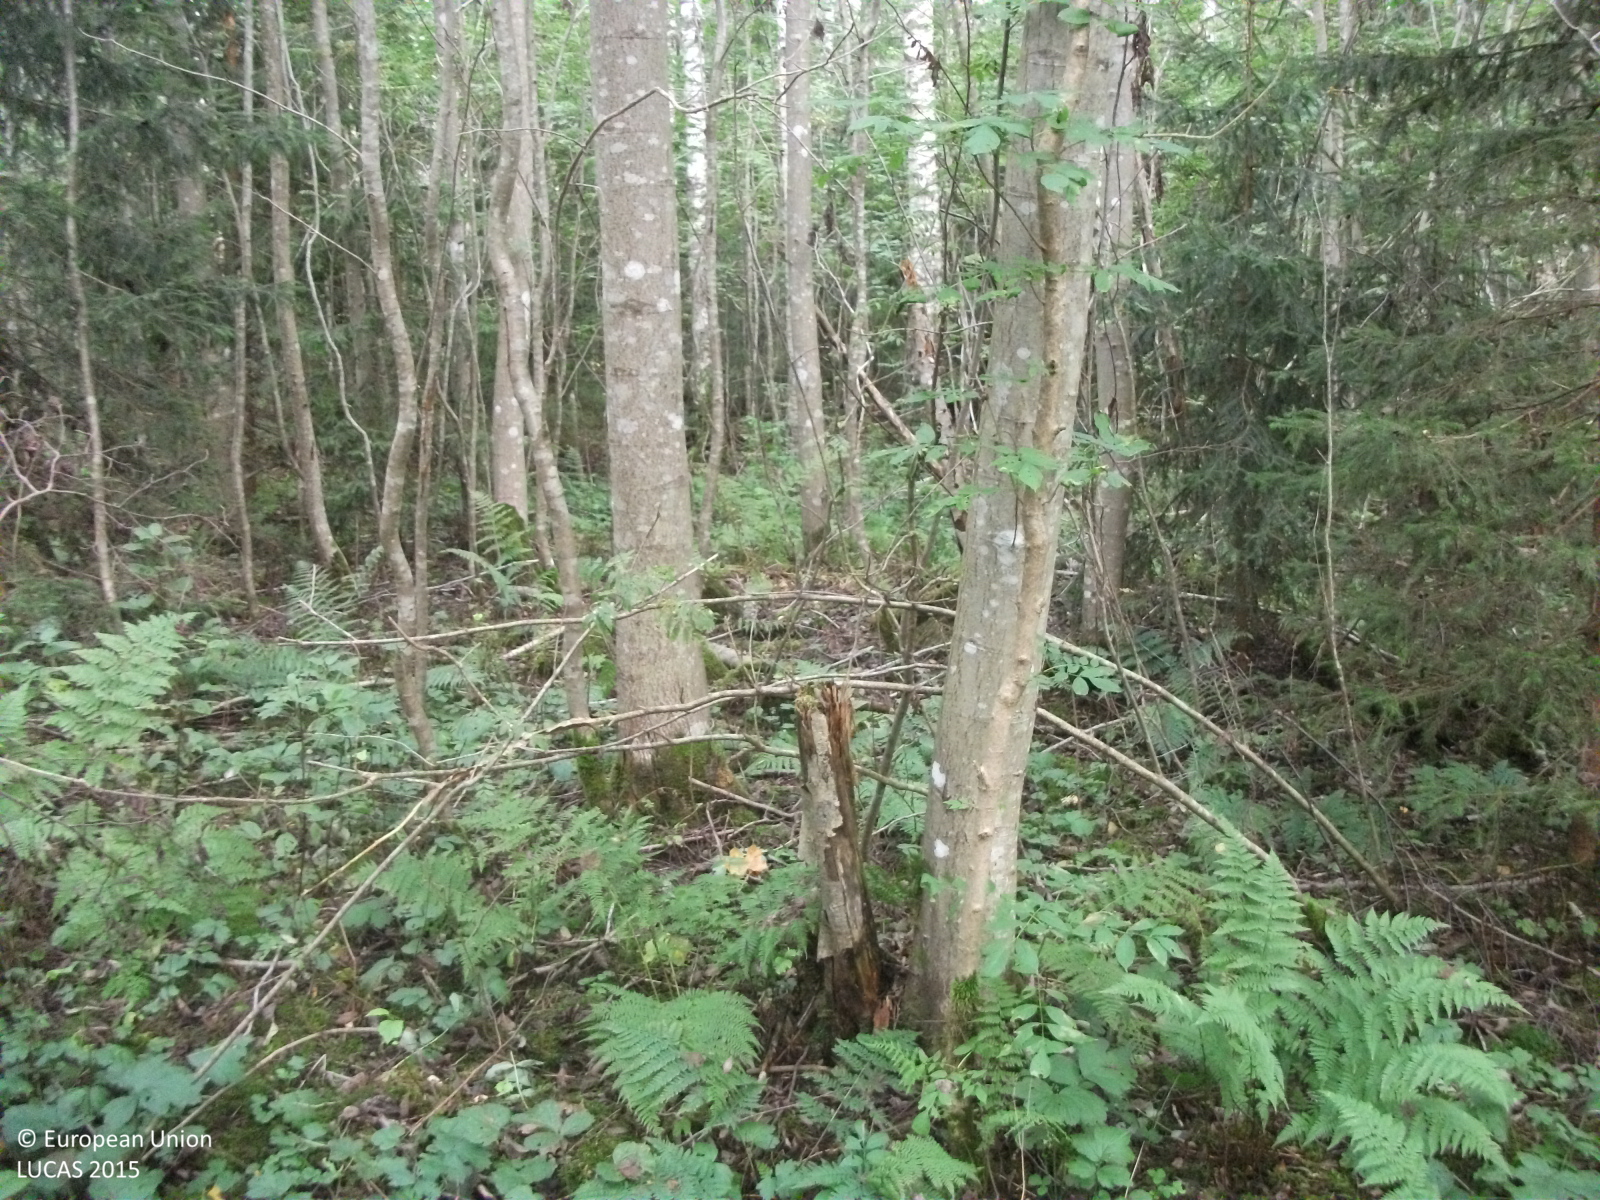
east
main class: Woodland
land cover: Broadleaved woodland
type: non-riverine alder, birch or aspen forest
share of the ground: > 75 %
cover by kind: broadleaved forest trees 85 %, herbaceous plants 10 %, coniferous forest trees 5 %
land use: Forestry
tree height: > 5 m
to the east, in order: Broadleaved woodland; Spruce dominated mixed woodland; Spruce dominated coniferous woodland
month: September
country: LV
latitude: 57.5926
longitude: 24.4946
